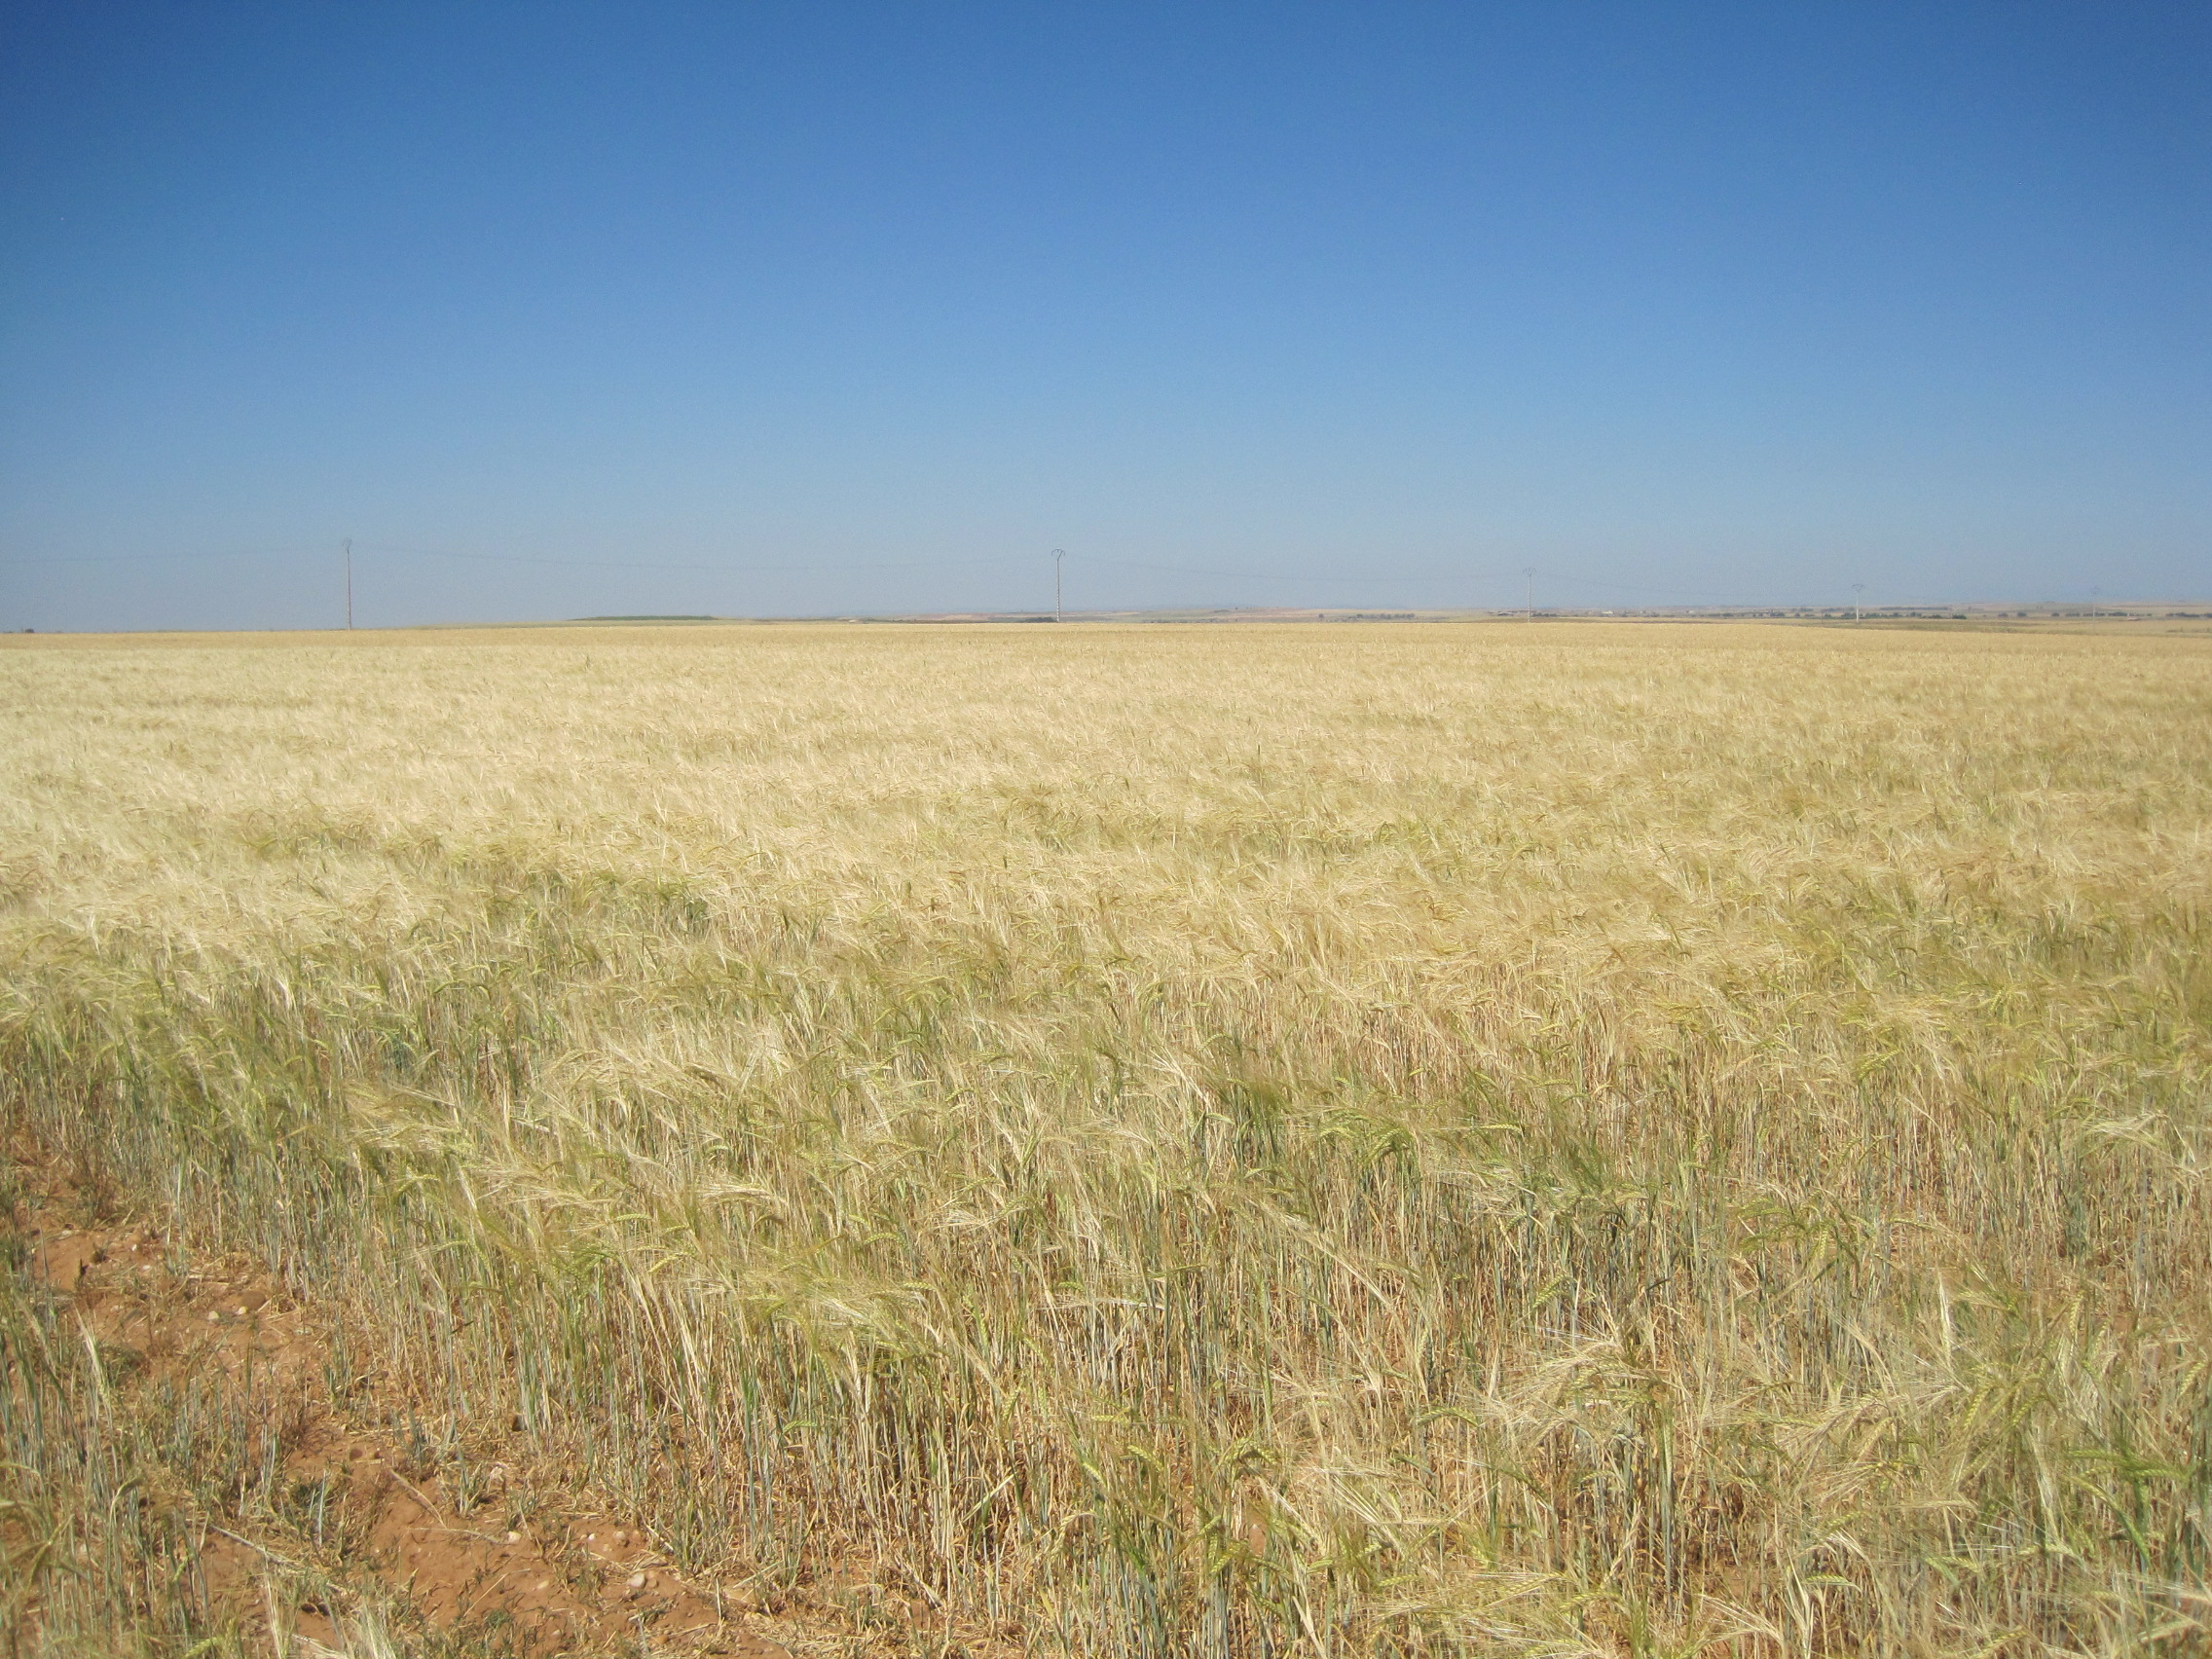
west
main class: Cropland
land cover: Barley
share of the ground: > 75 %
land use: Agriculture (excluding fallow land and kitchen gardens)
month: June
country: ES
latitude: 41.8368
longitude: -5.3893
